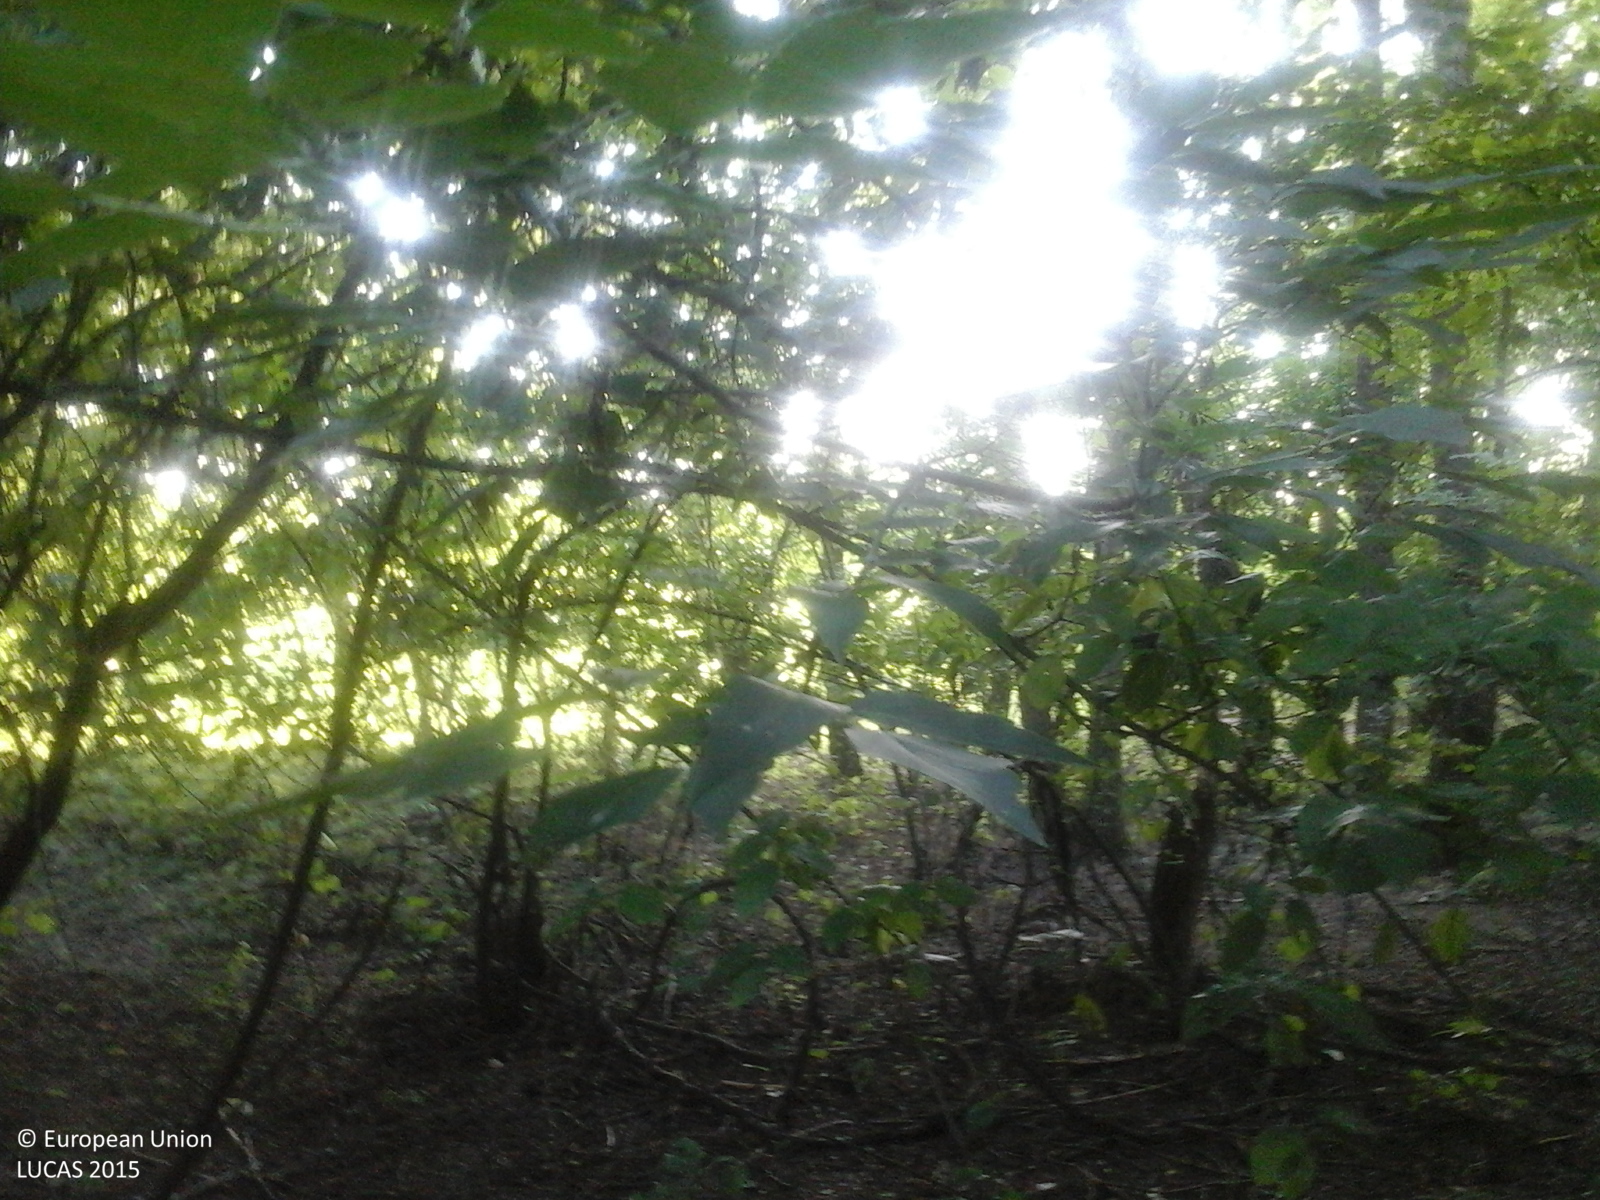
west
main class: Woodland
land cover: Broadleaved woodland
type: mesophytic deciduous forest
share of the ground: > 75 %
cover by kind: broadleaved forest trees 100 %
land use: Forestry
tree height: > 5 m
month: July
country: RO
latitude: 44.5860
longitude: 25.5226
